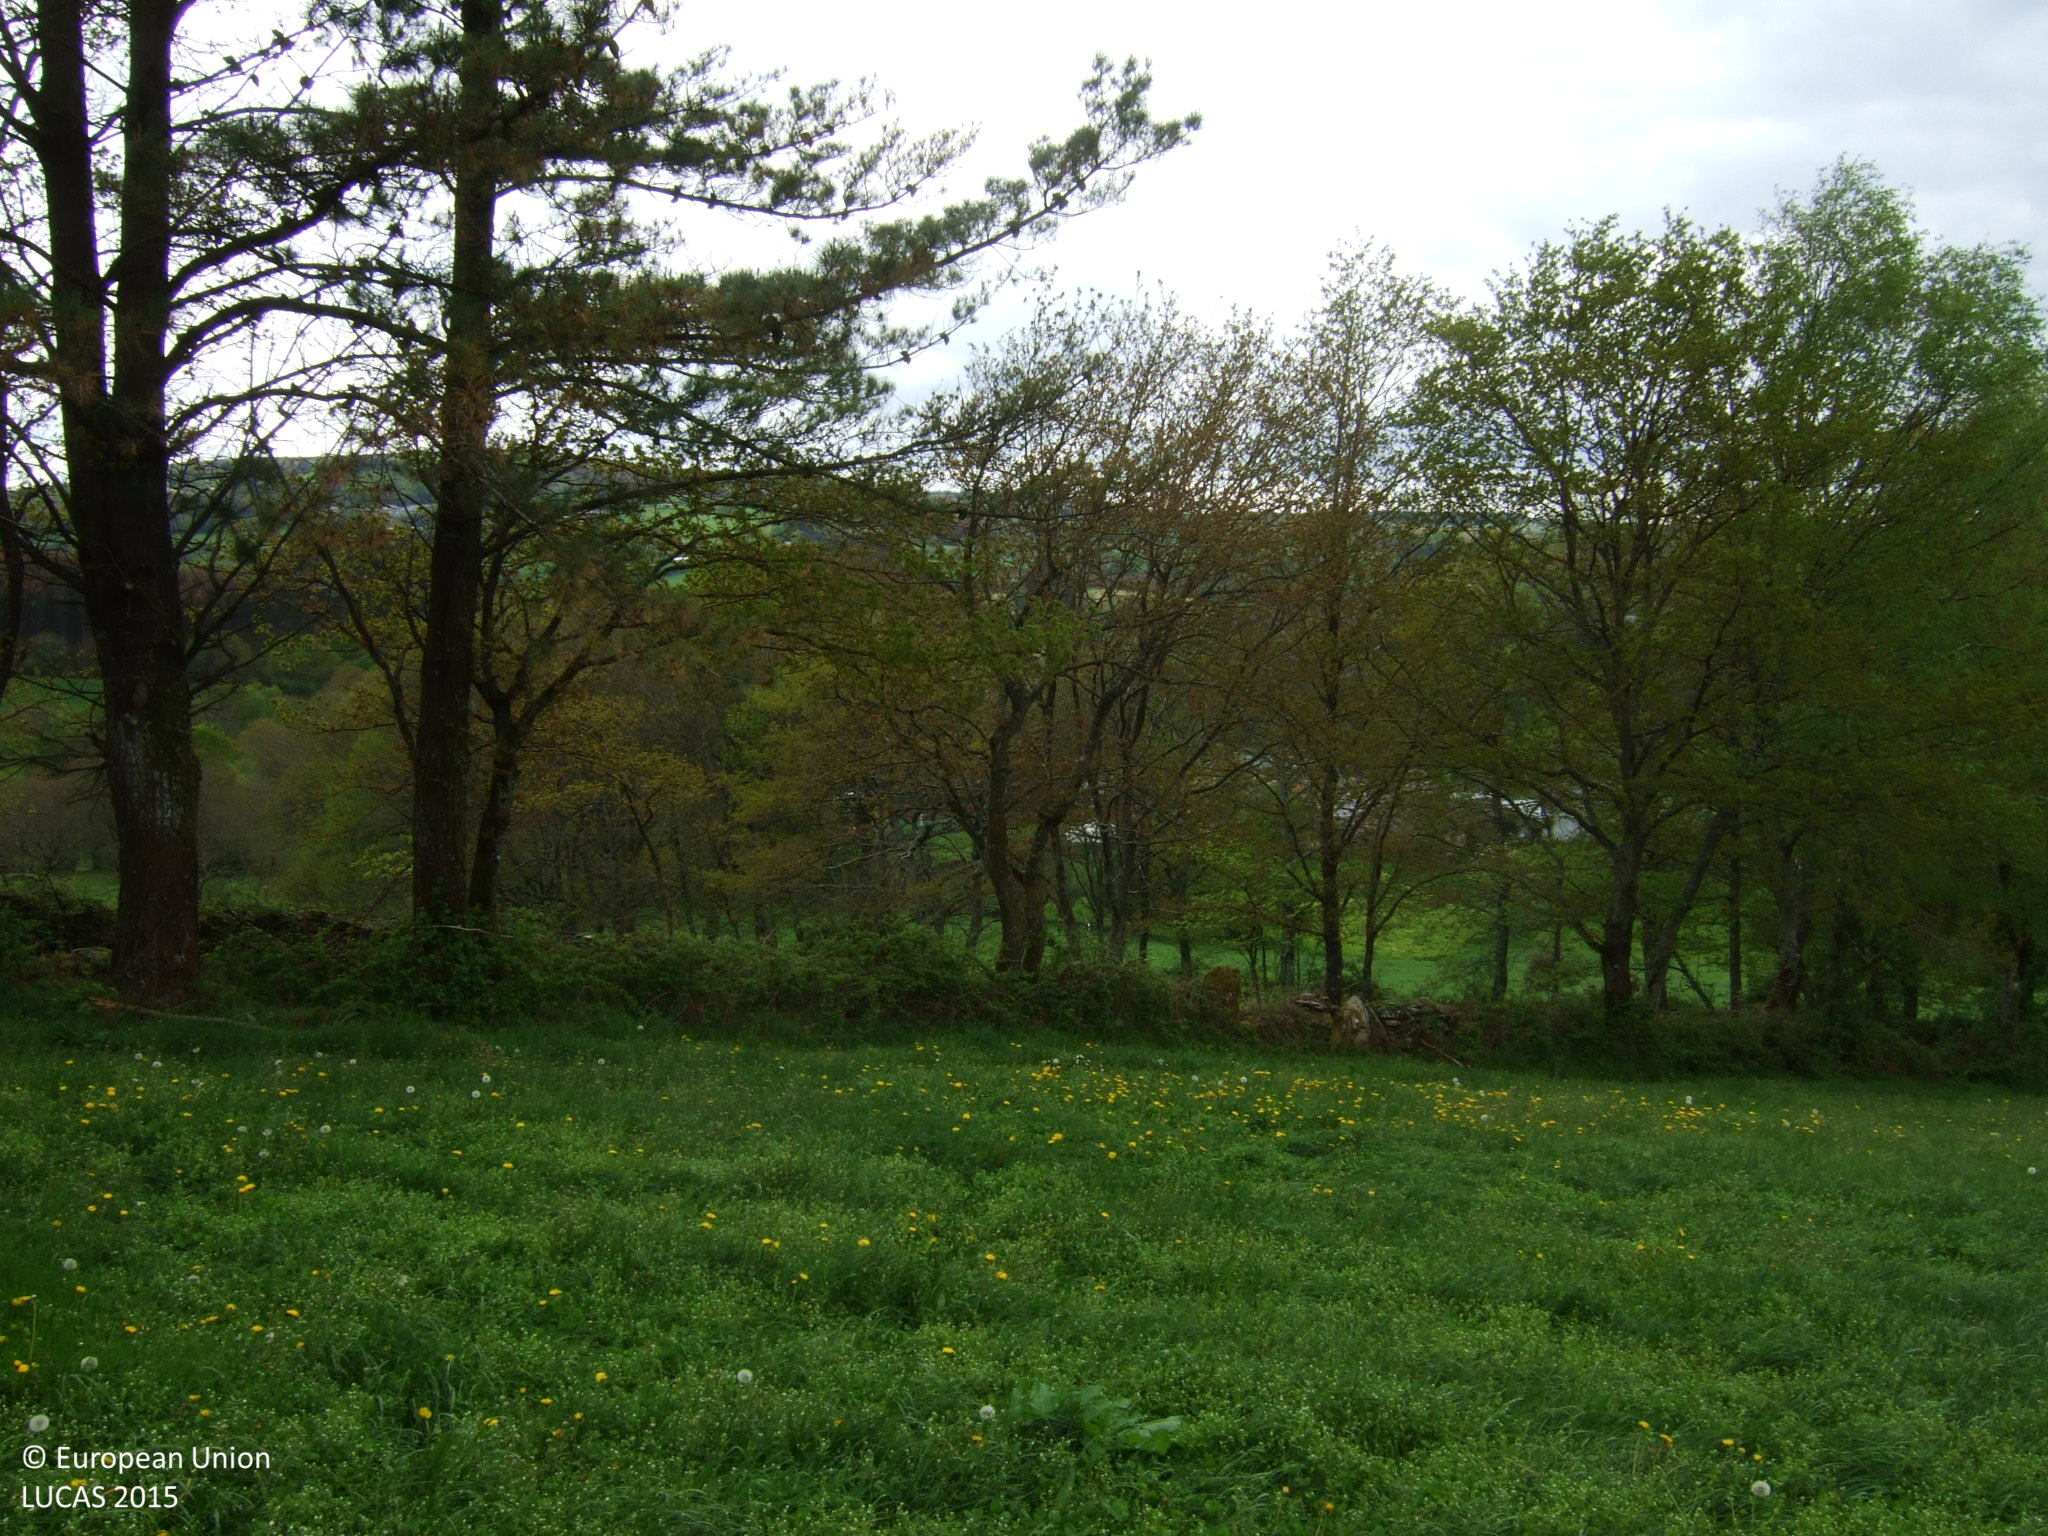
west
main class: Grassland
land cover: Grassland without tree/shrub cover
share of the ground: > 75 %
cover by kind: herbaceous plants 100 %
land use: Agriculture (excluding fallow land and kitchen gardens)
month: April
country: ES
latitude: 42.9890
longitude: -7.8568
